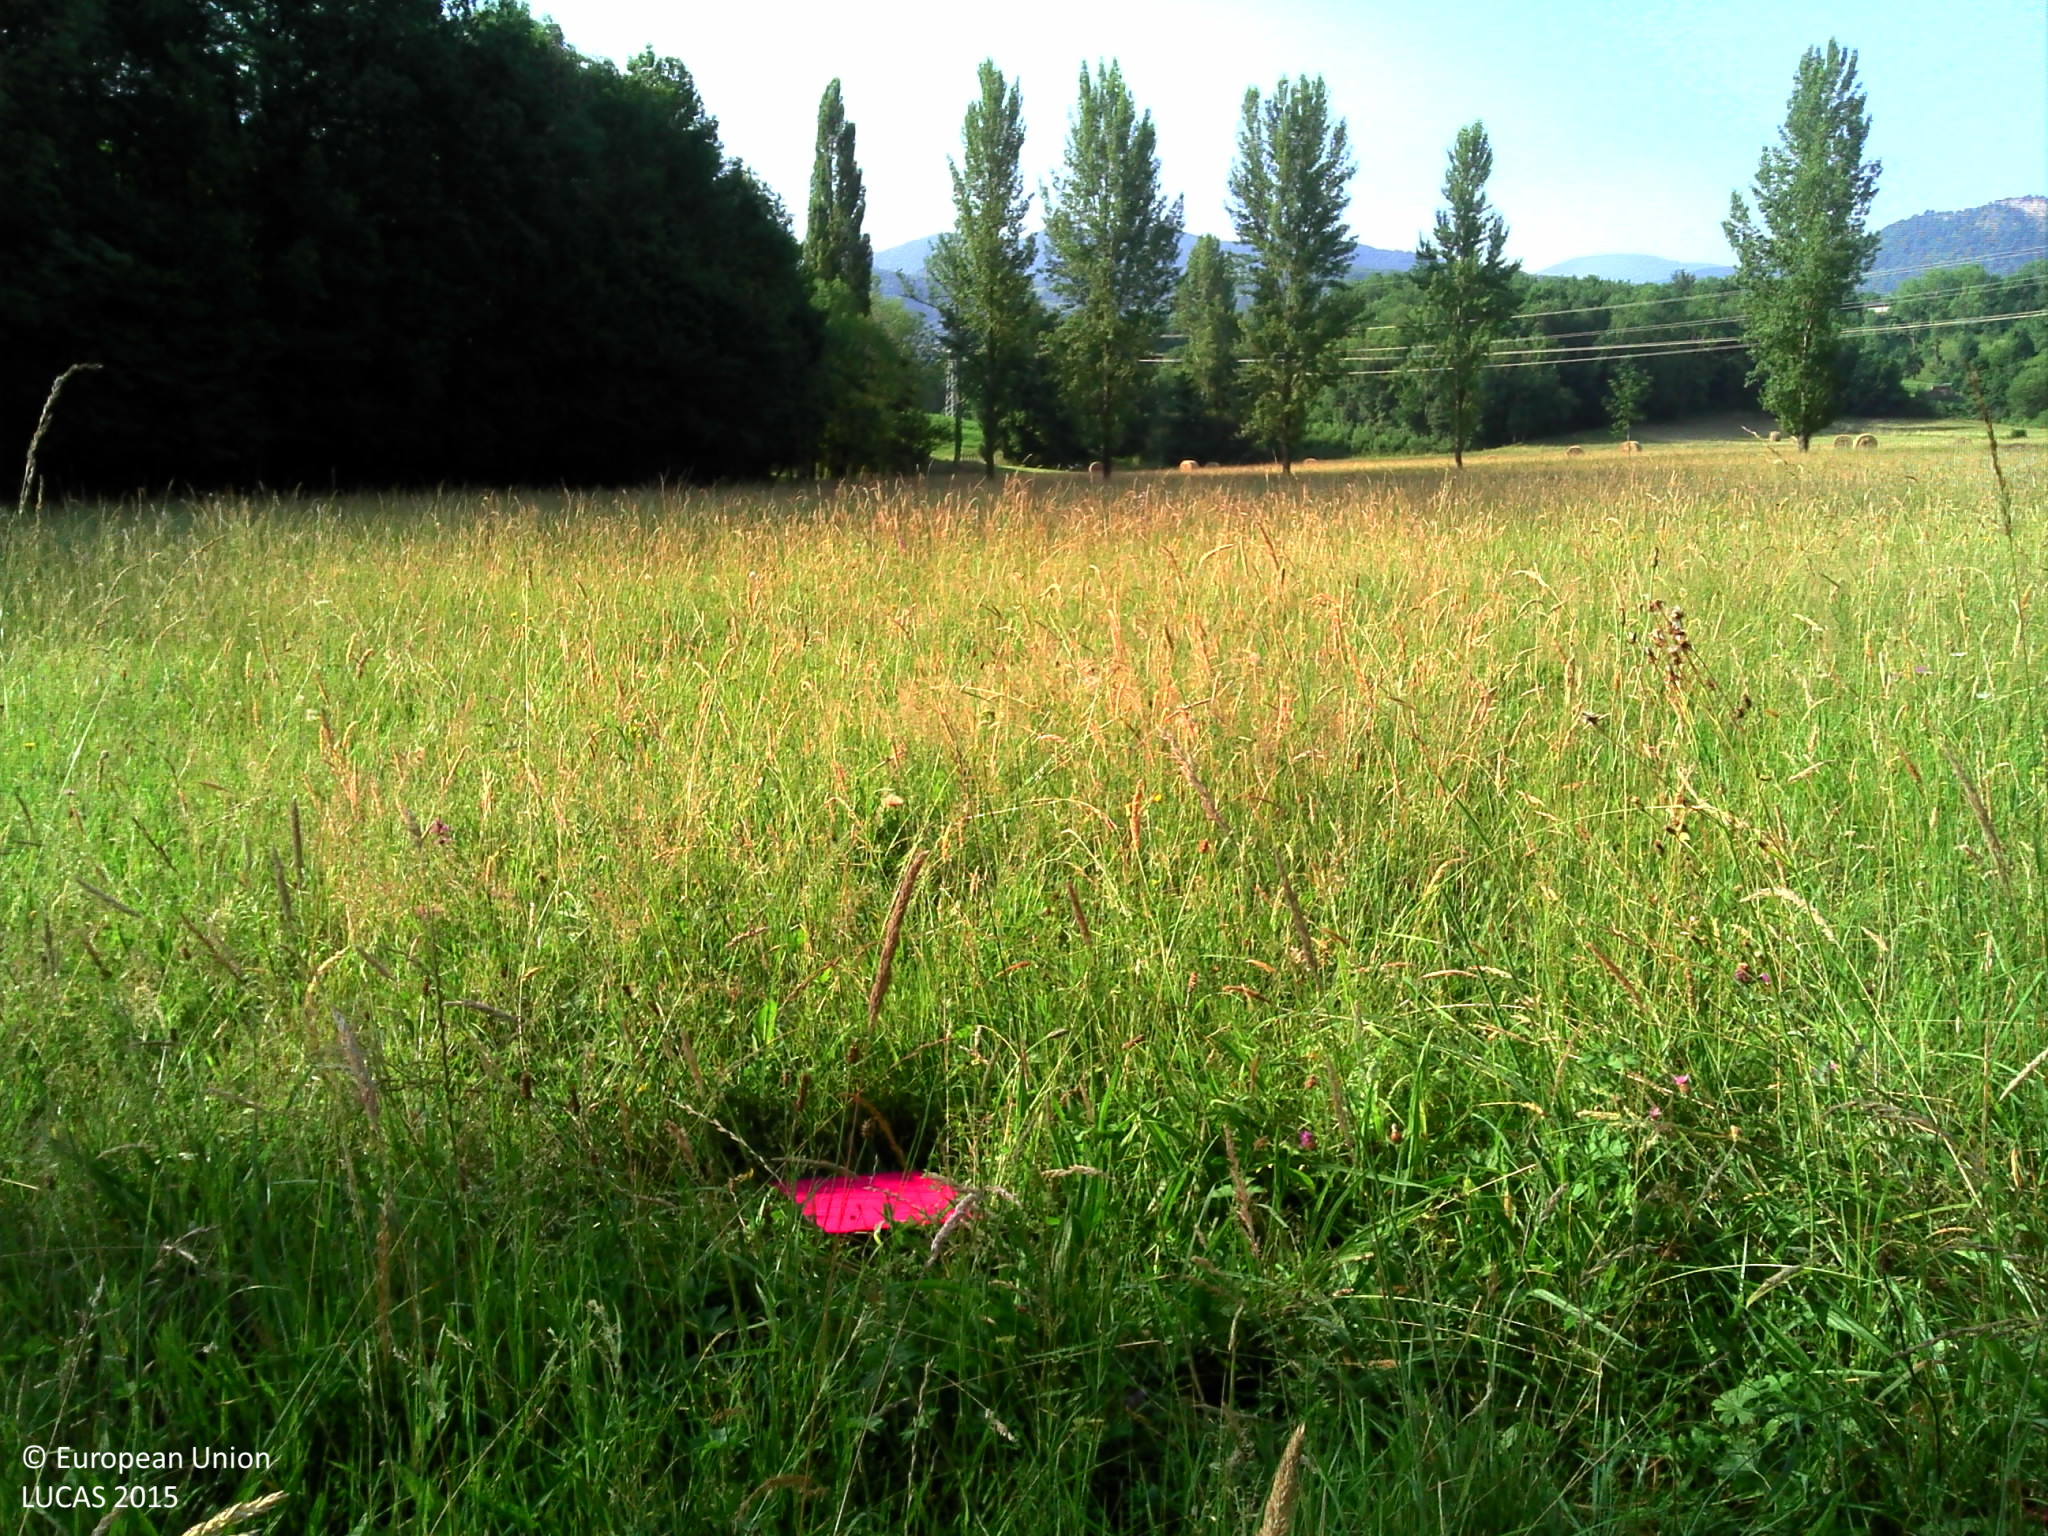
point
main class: Grassland
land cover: Grassland without tree/shrub cover
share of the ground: > 75 %
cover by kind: herbaceous plants 100 %
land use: Agriculture (excluding fallow land and kitchen gardens)
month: July
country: FR
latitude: 42.9889
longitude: 1.1128
